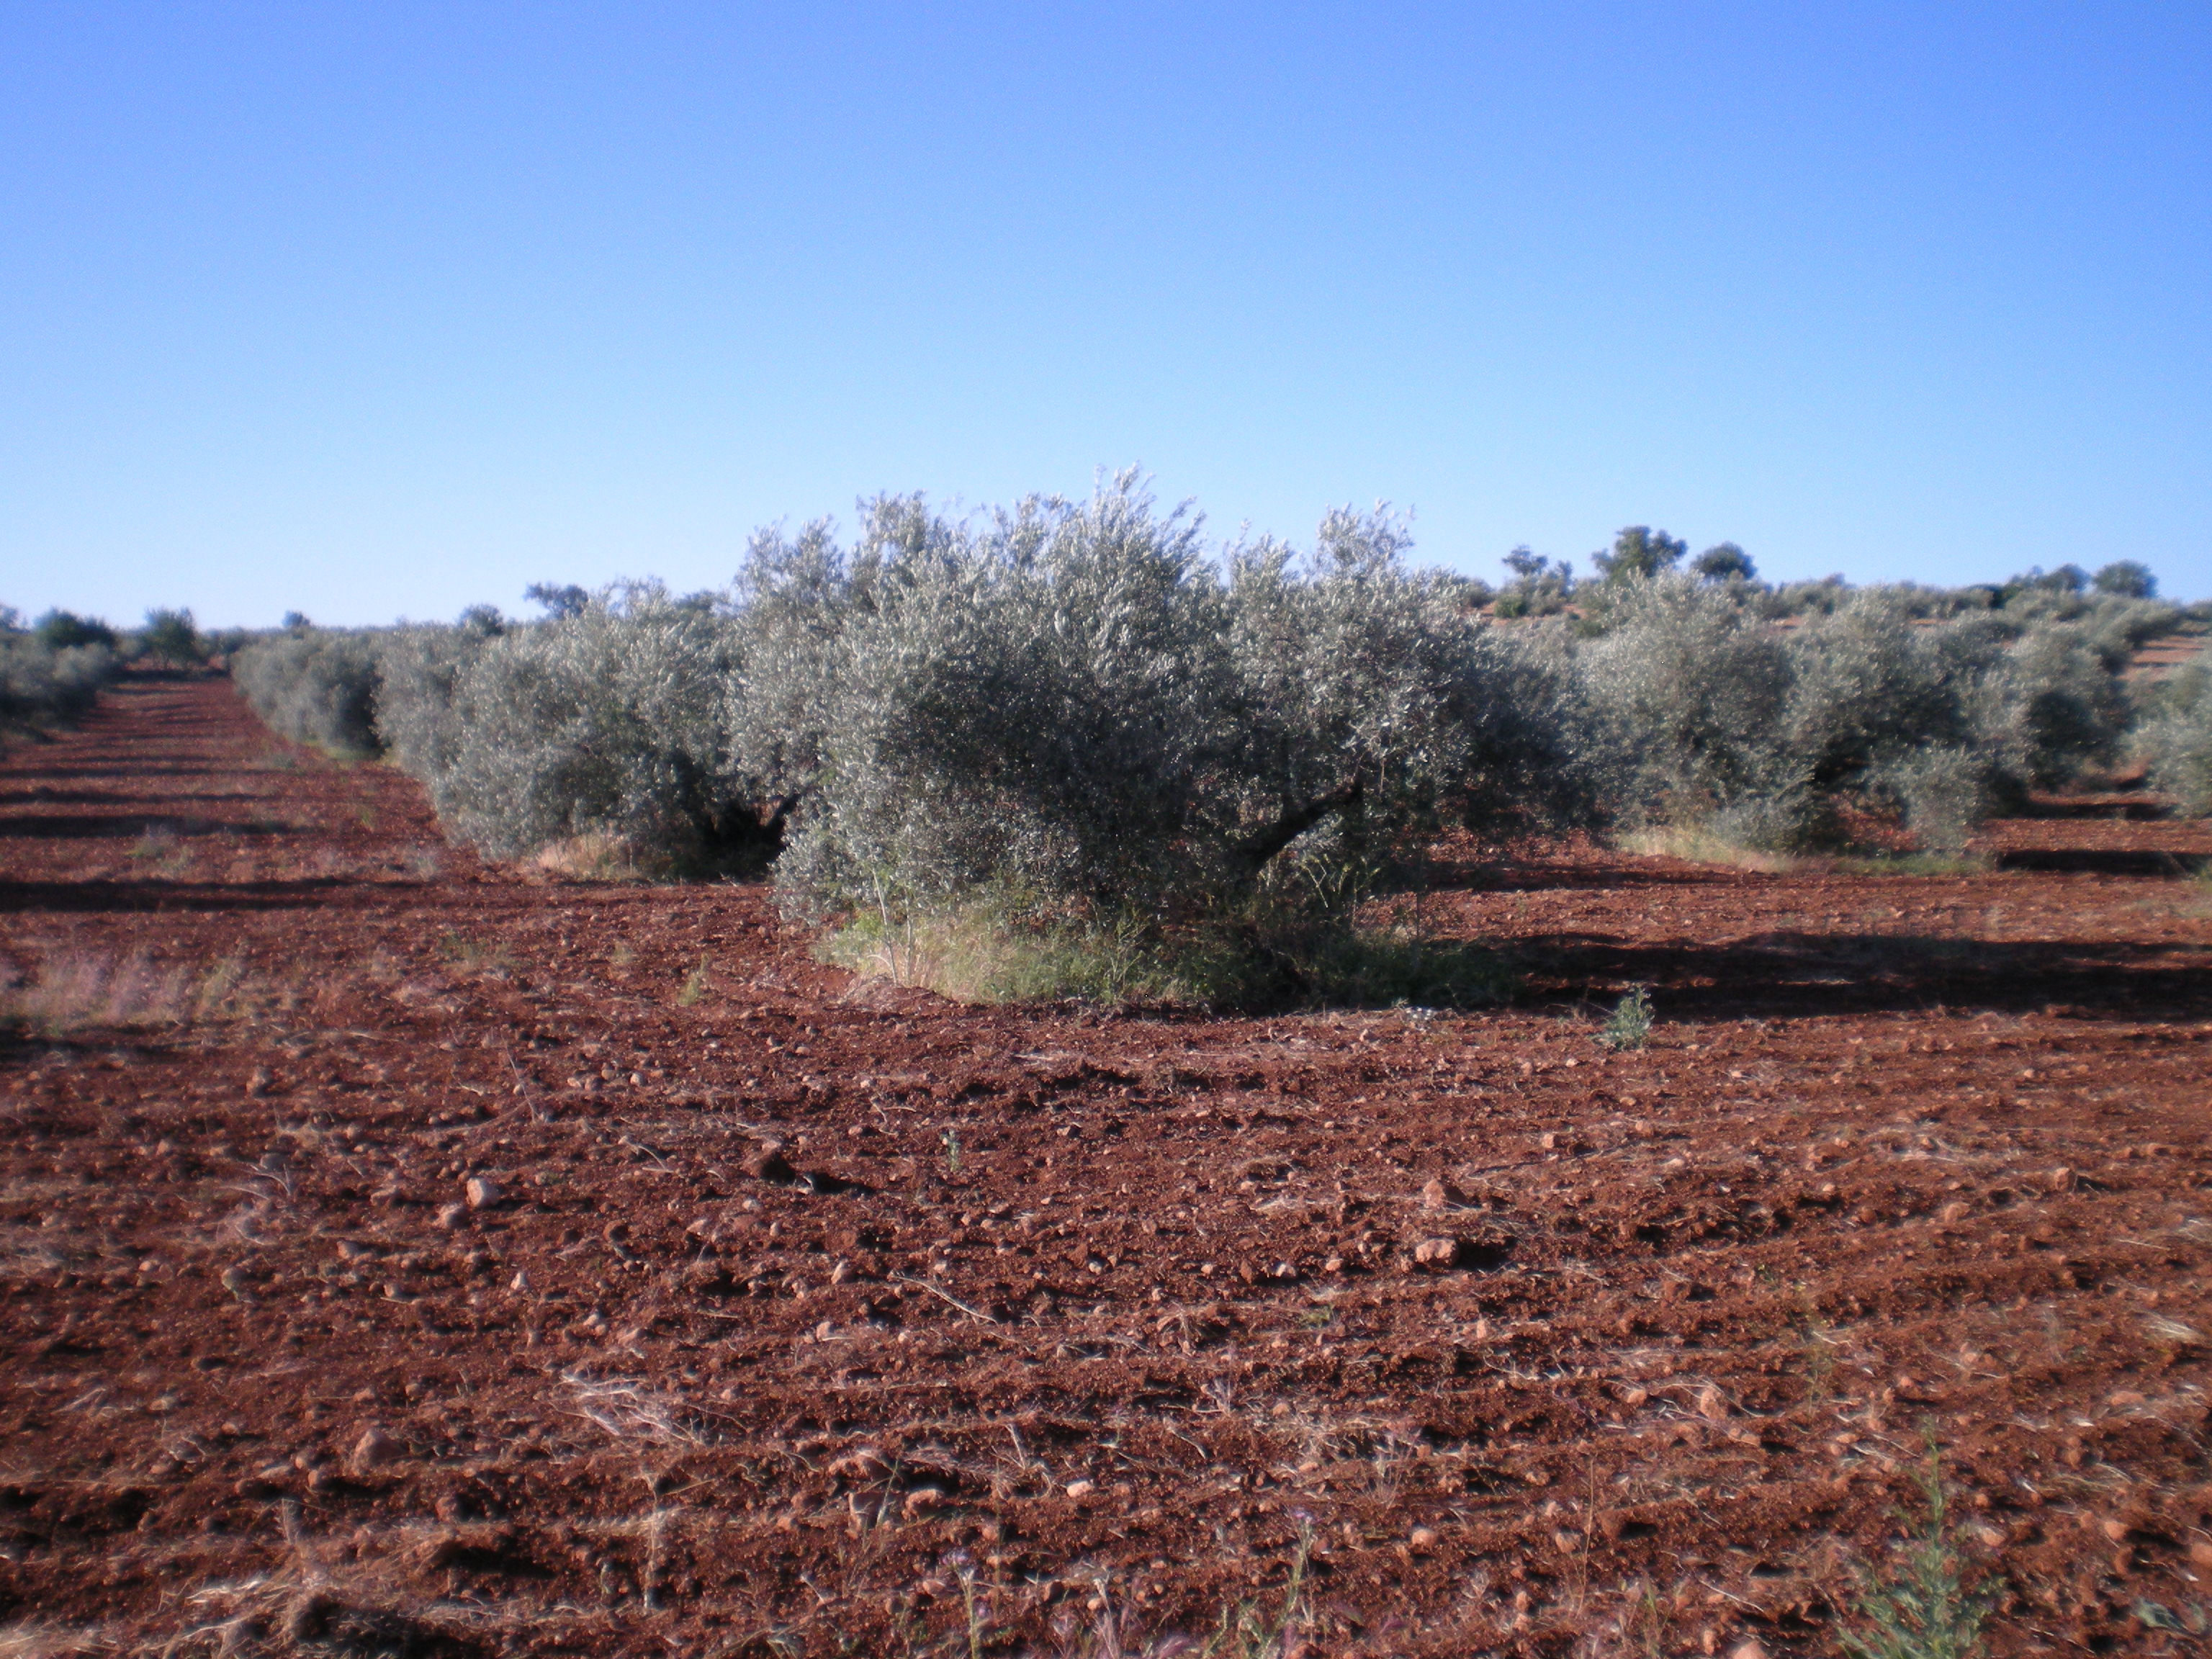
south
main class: Cropland
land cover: Olive groves
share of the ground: 10 - 25 %
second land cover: Other bare soil
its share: > 75 %
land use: Agriculture (excluding fallow land and kitchen gardens)
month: May
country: ES
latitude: 38.6746
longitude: -2.9362
